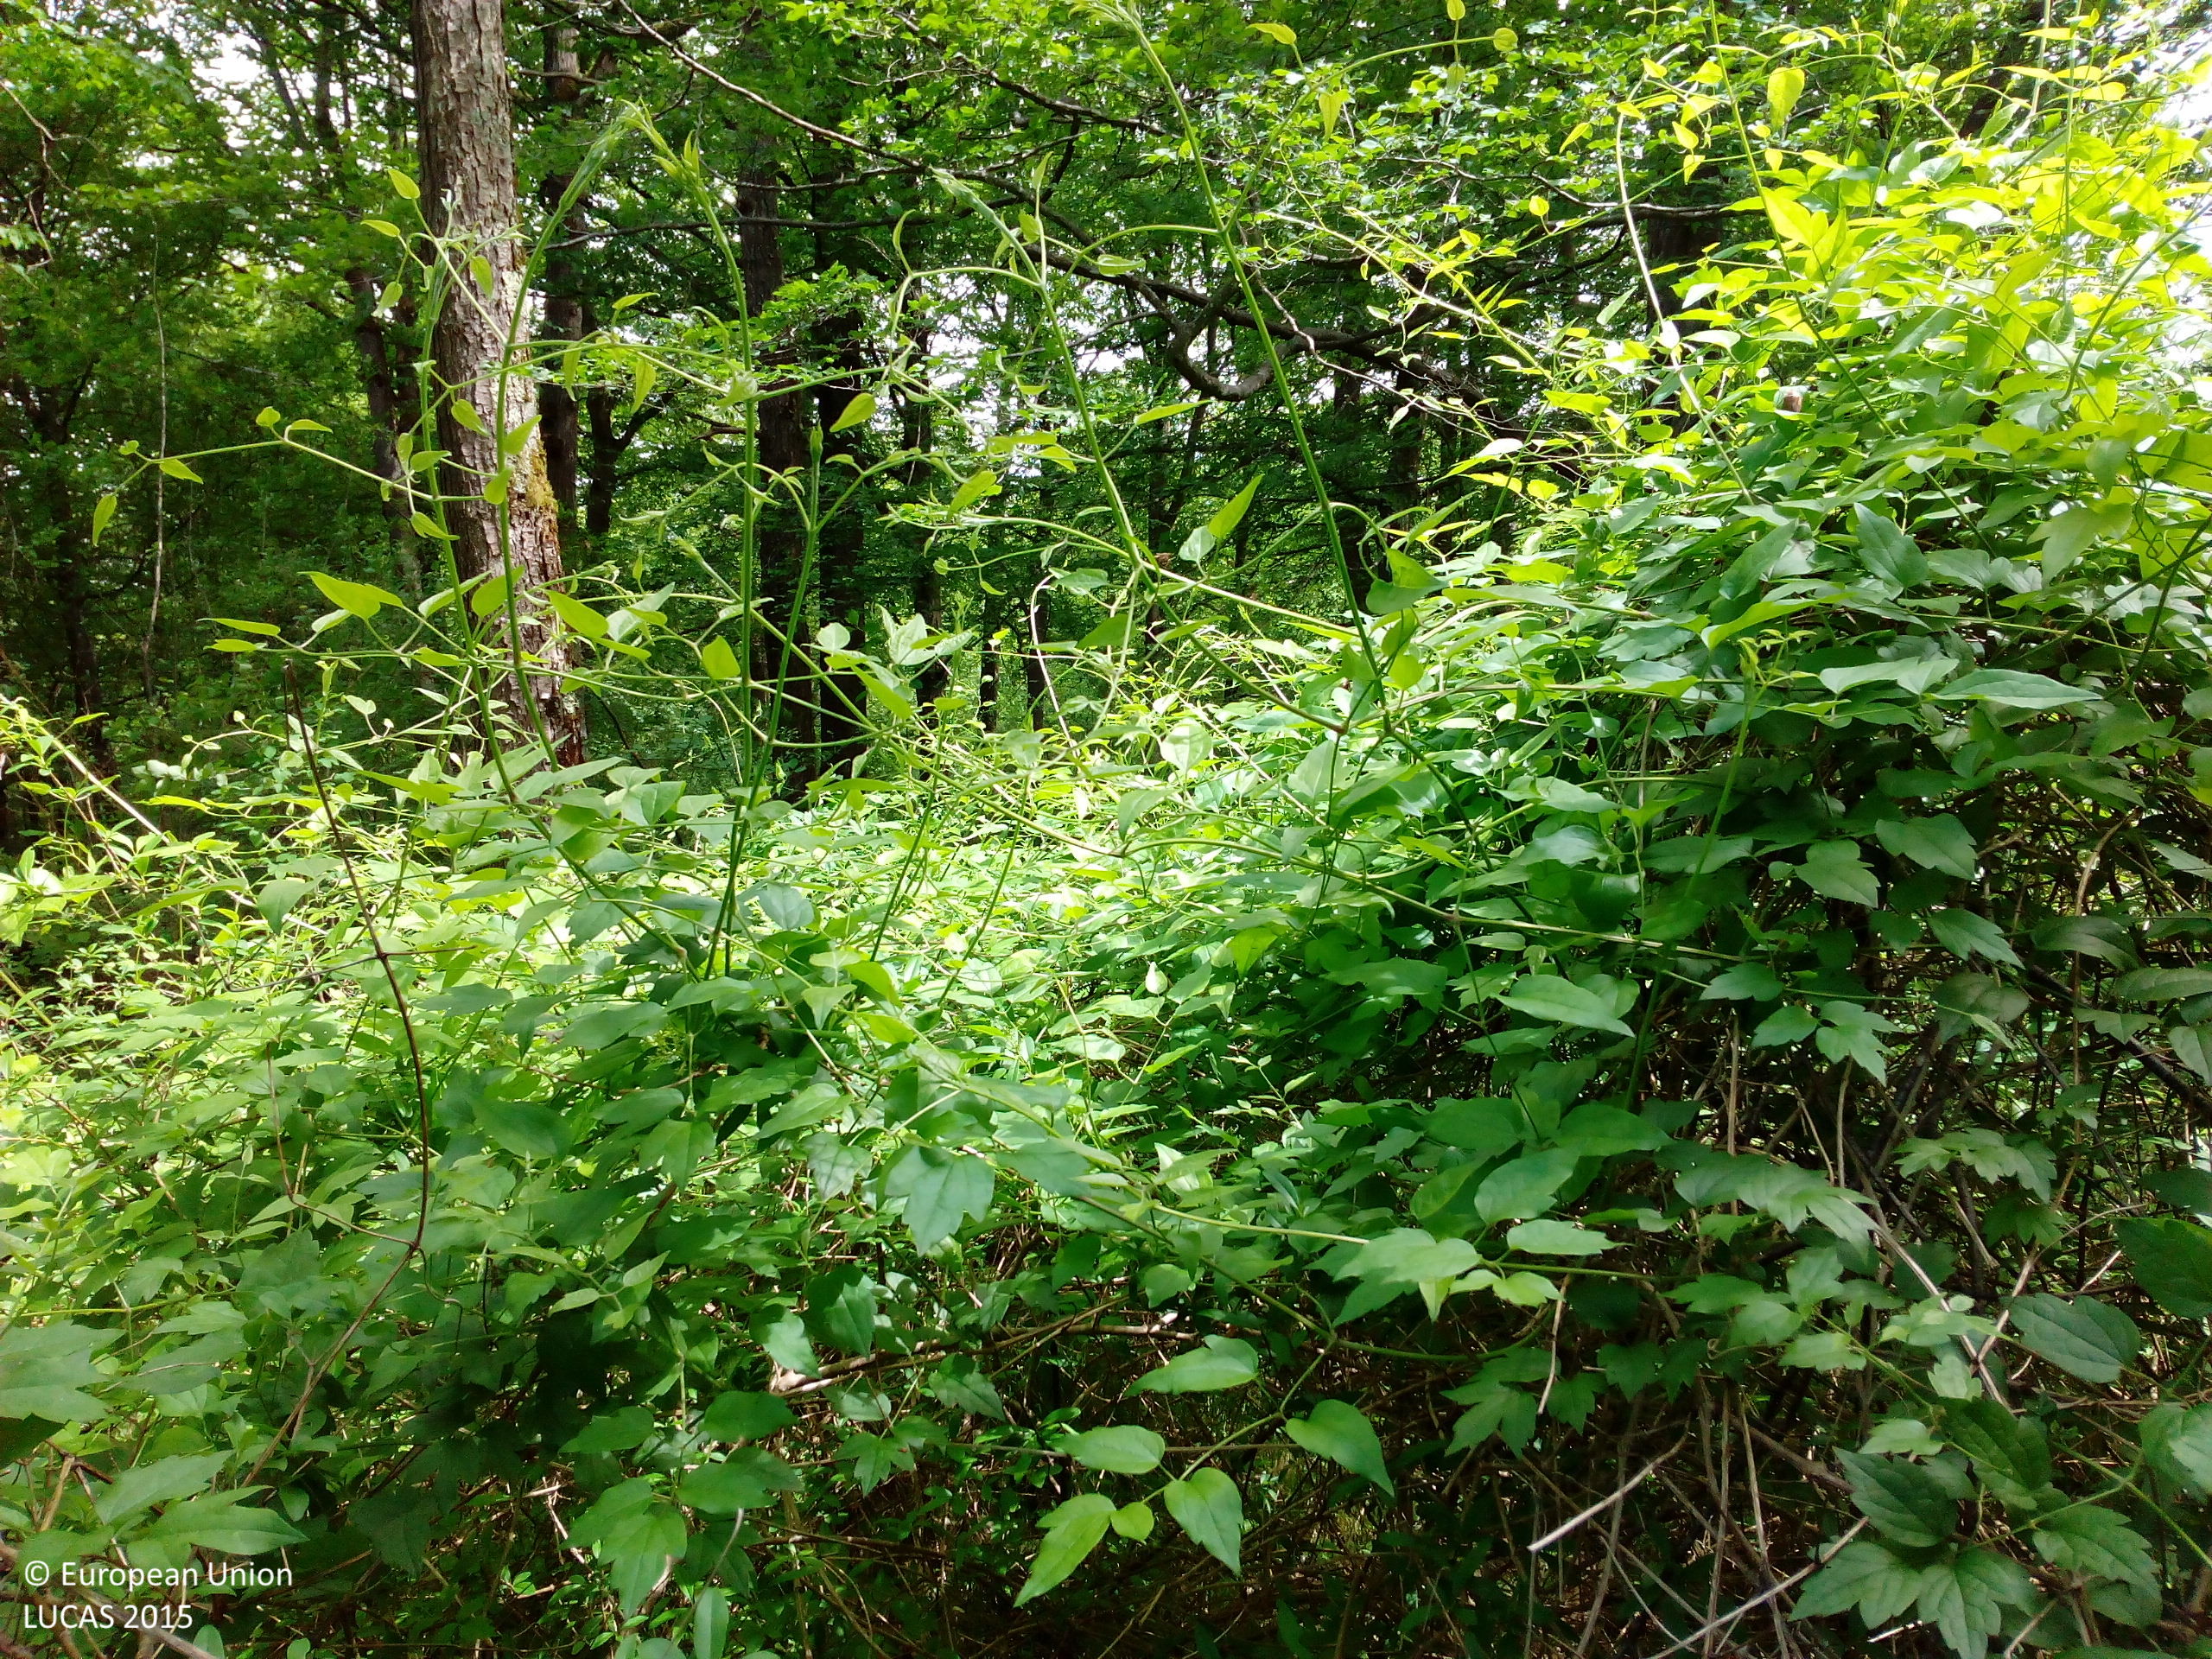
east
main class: Woodland
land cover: Broadleaved woodland
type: floodplain forest
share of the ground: > 75 %
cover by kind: broadleaved forest trees 85 %, shrubs 10 %, herbaceous plants 5 %
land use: Forestry
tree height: > 5 m
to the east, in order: Broadleaved woodland; Fences; Ditches and canals; Broadleaved woodland; Grassland without tree/shrub cover; Fences; Grassland without tree/shrub cover; Broadleaved woodland; Fences; Broadleaved woodland
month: May
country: DE
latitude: 47.9455
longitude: 7.6047
